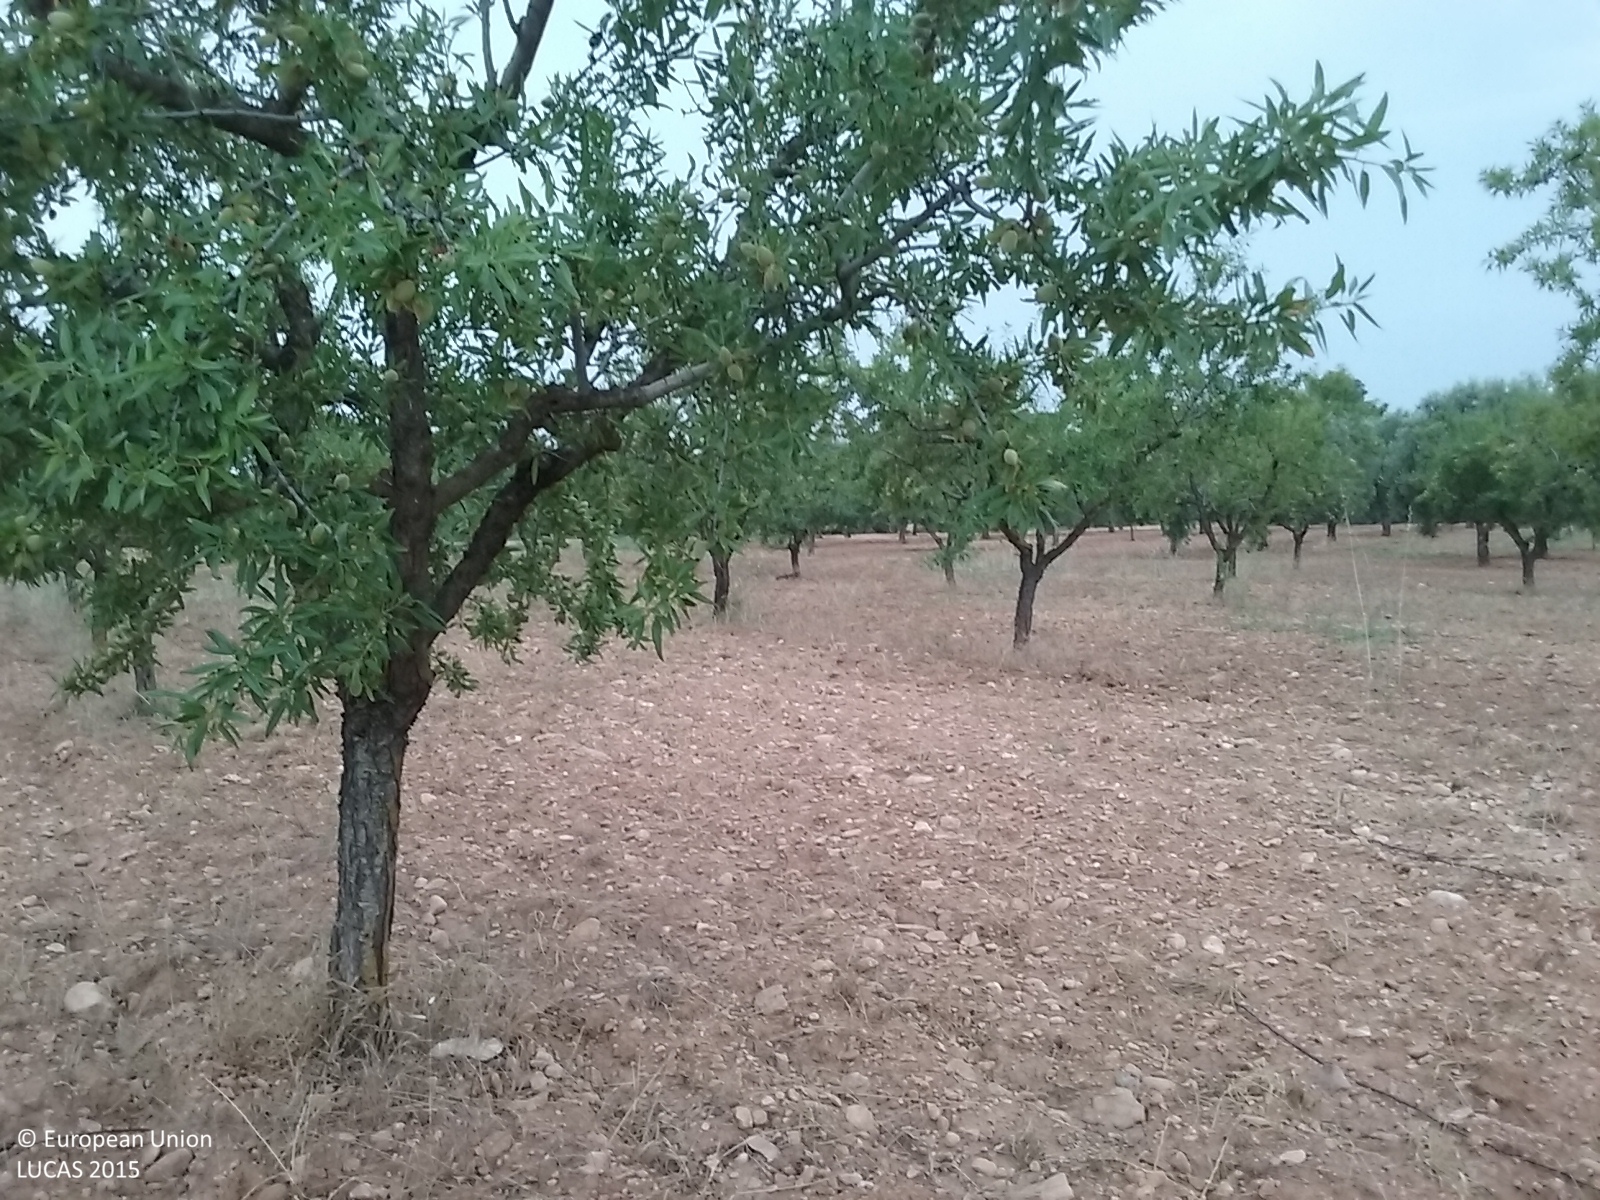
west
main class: Cropland
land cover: Nuts trees
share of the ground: 25 - 50 %
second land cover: Other bare soil
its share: > 75 %
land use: Agriculture (excluding fallow land and kitchen gardens)
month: June
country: ES
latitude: 40.9089
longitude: 0.2448
